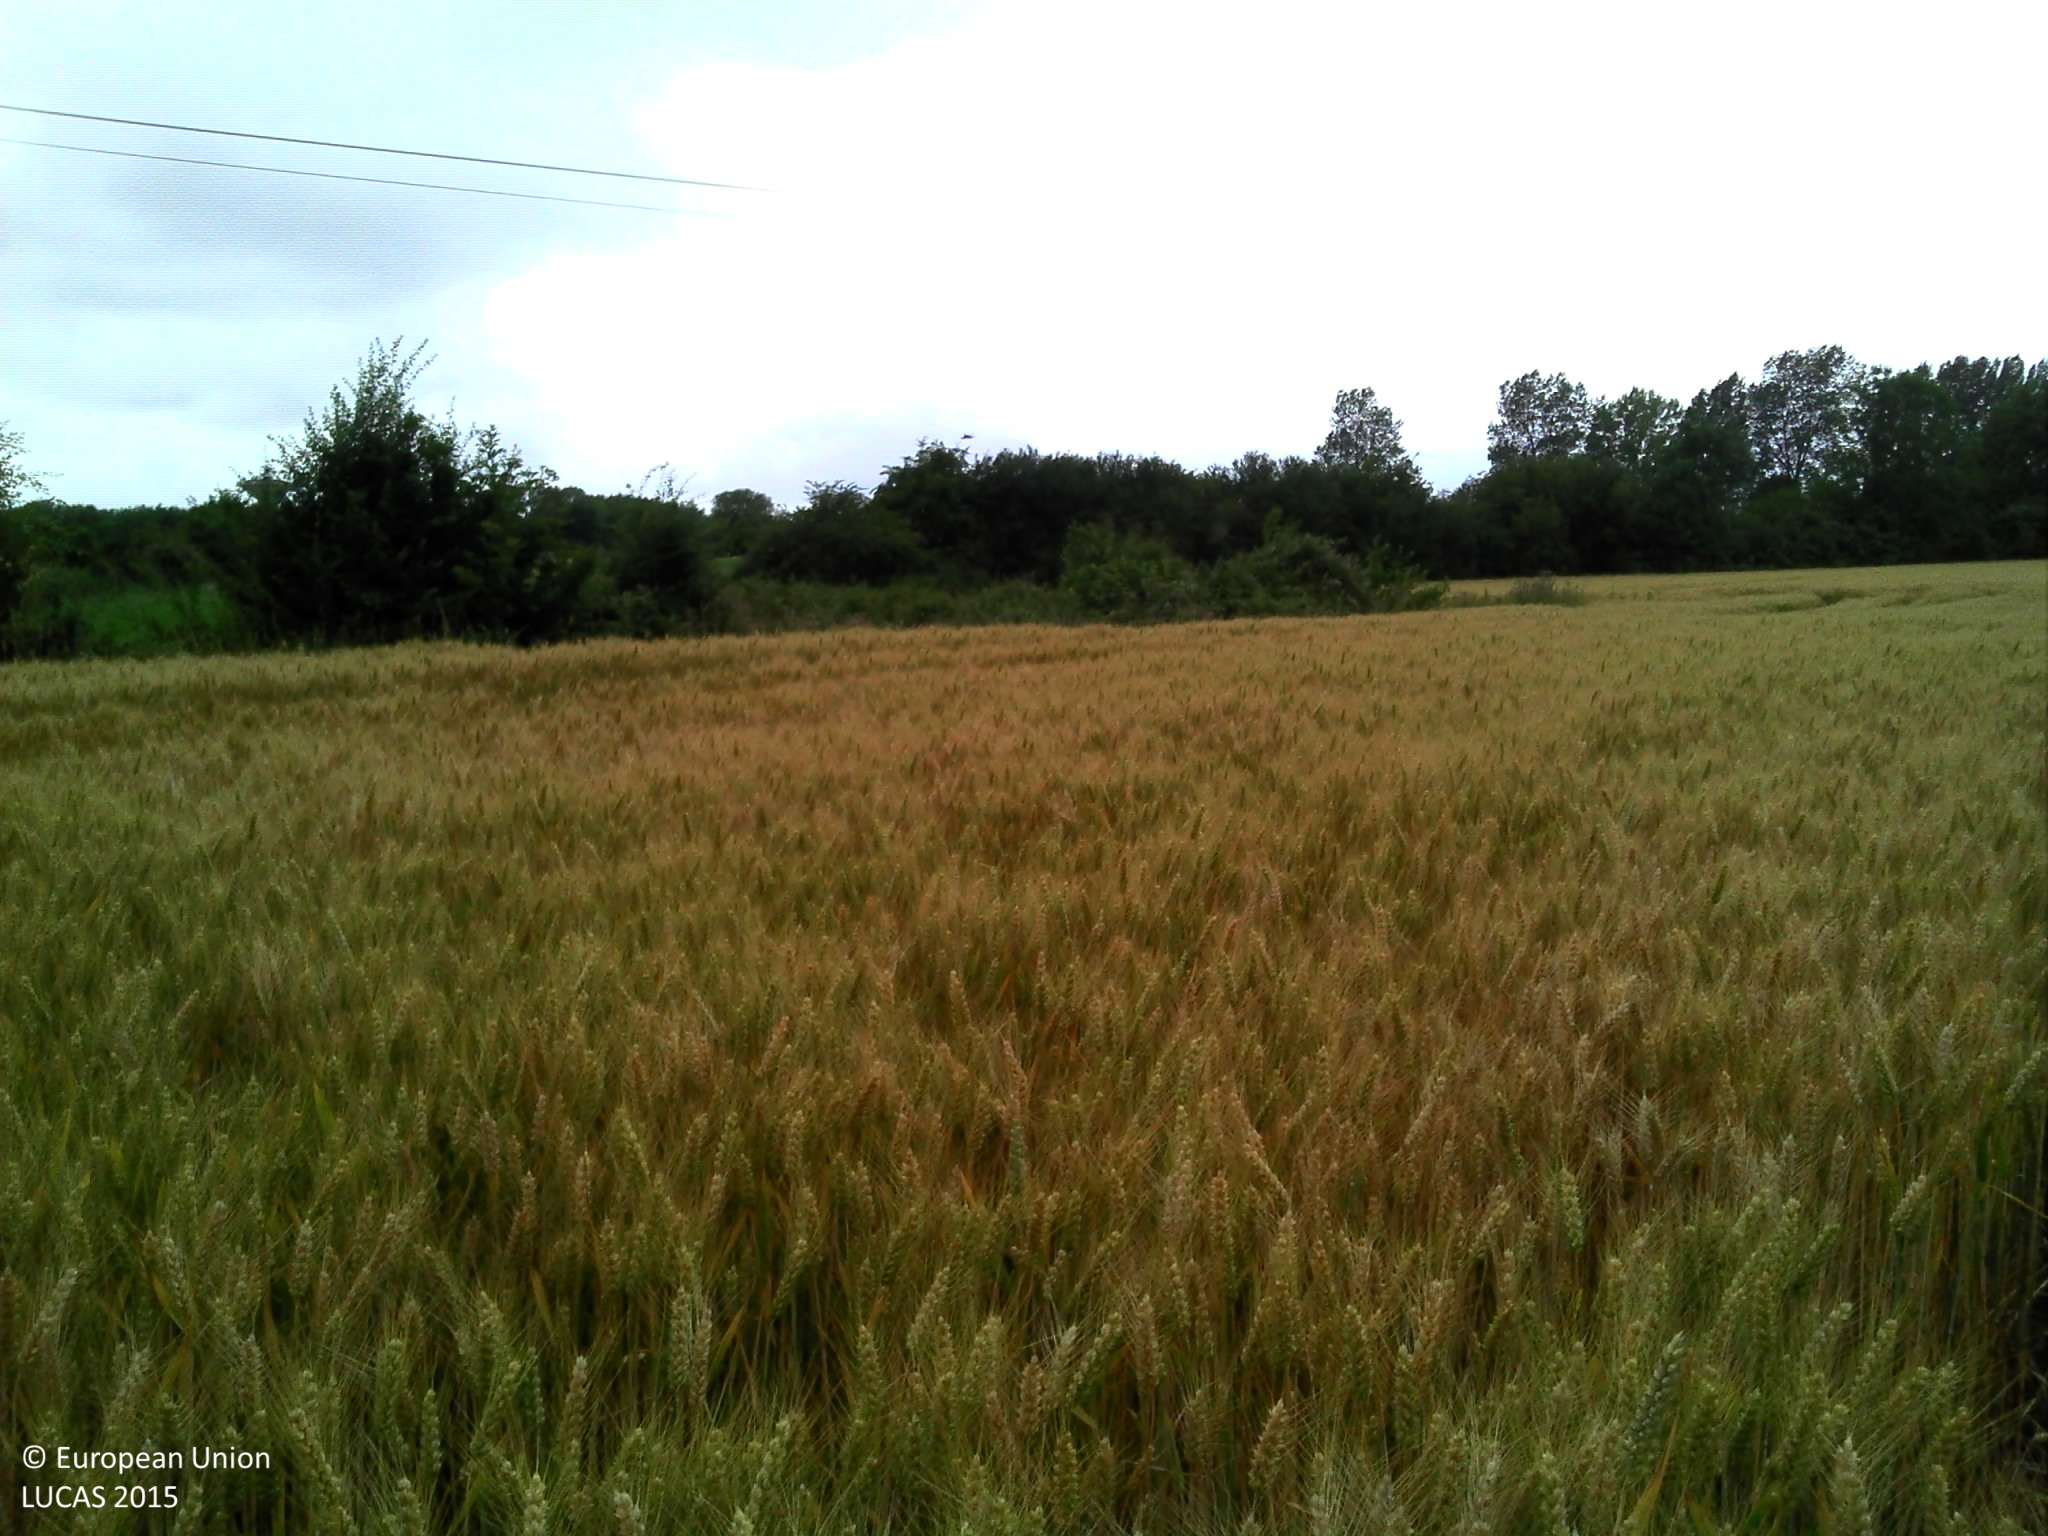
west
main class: Cropland
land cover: Common wheat
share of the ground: > 75 %
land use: Agriculture (excluding fallow land and kitchen gardens)
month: July
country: FR
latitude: 50.7700
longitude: 3.1134
